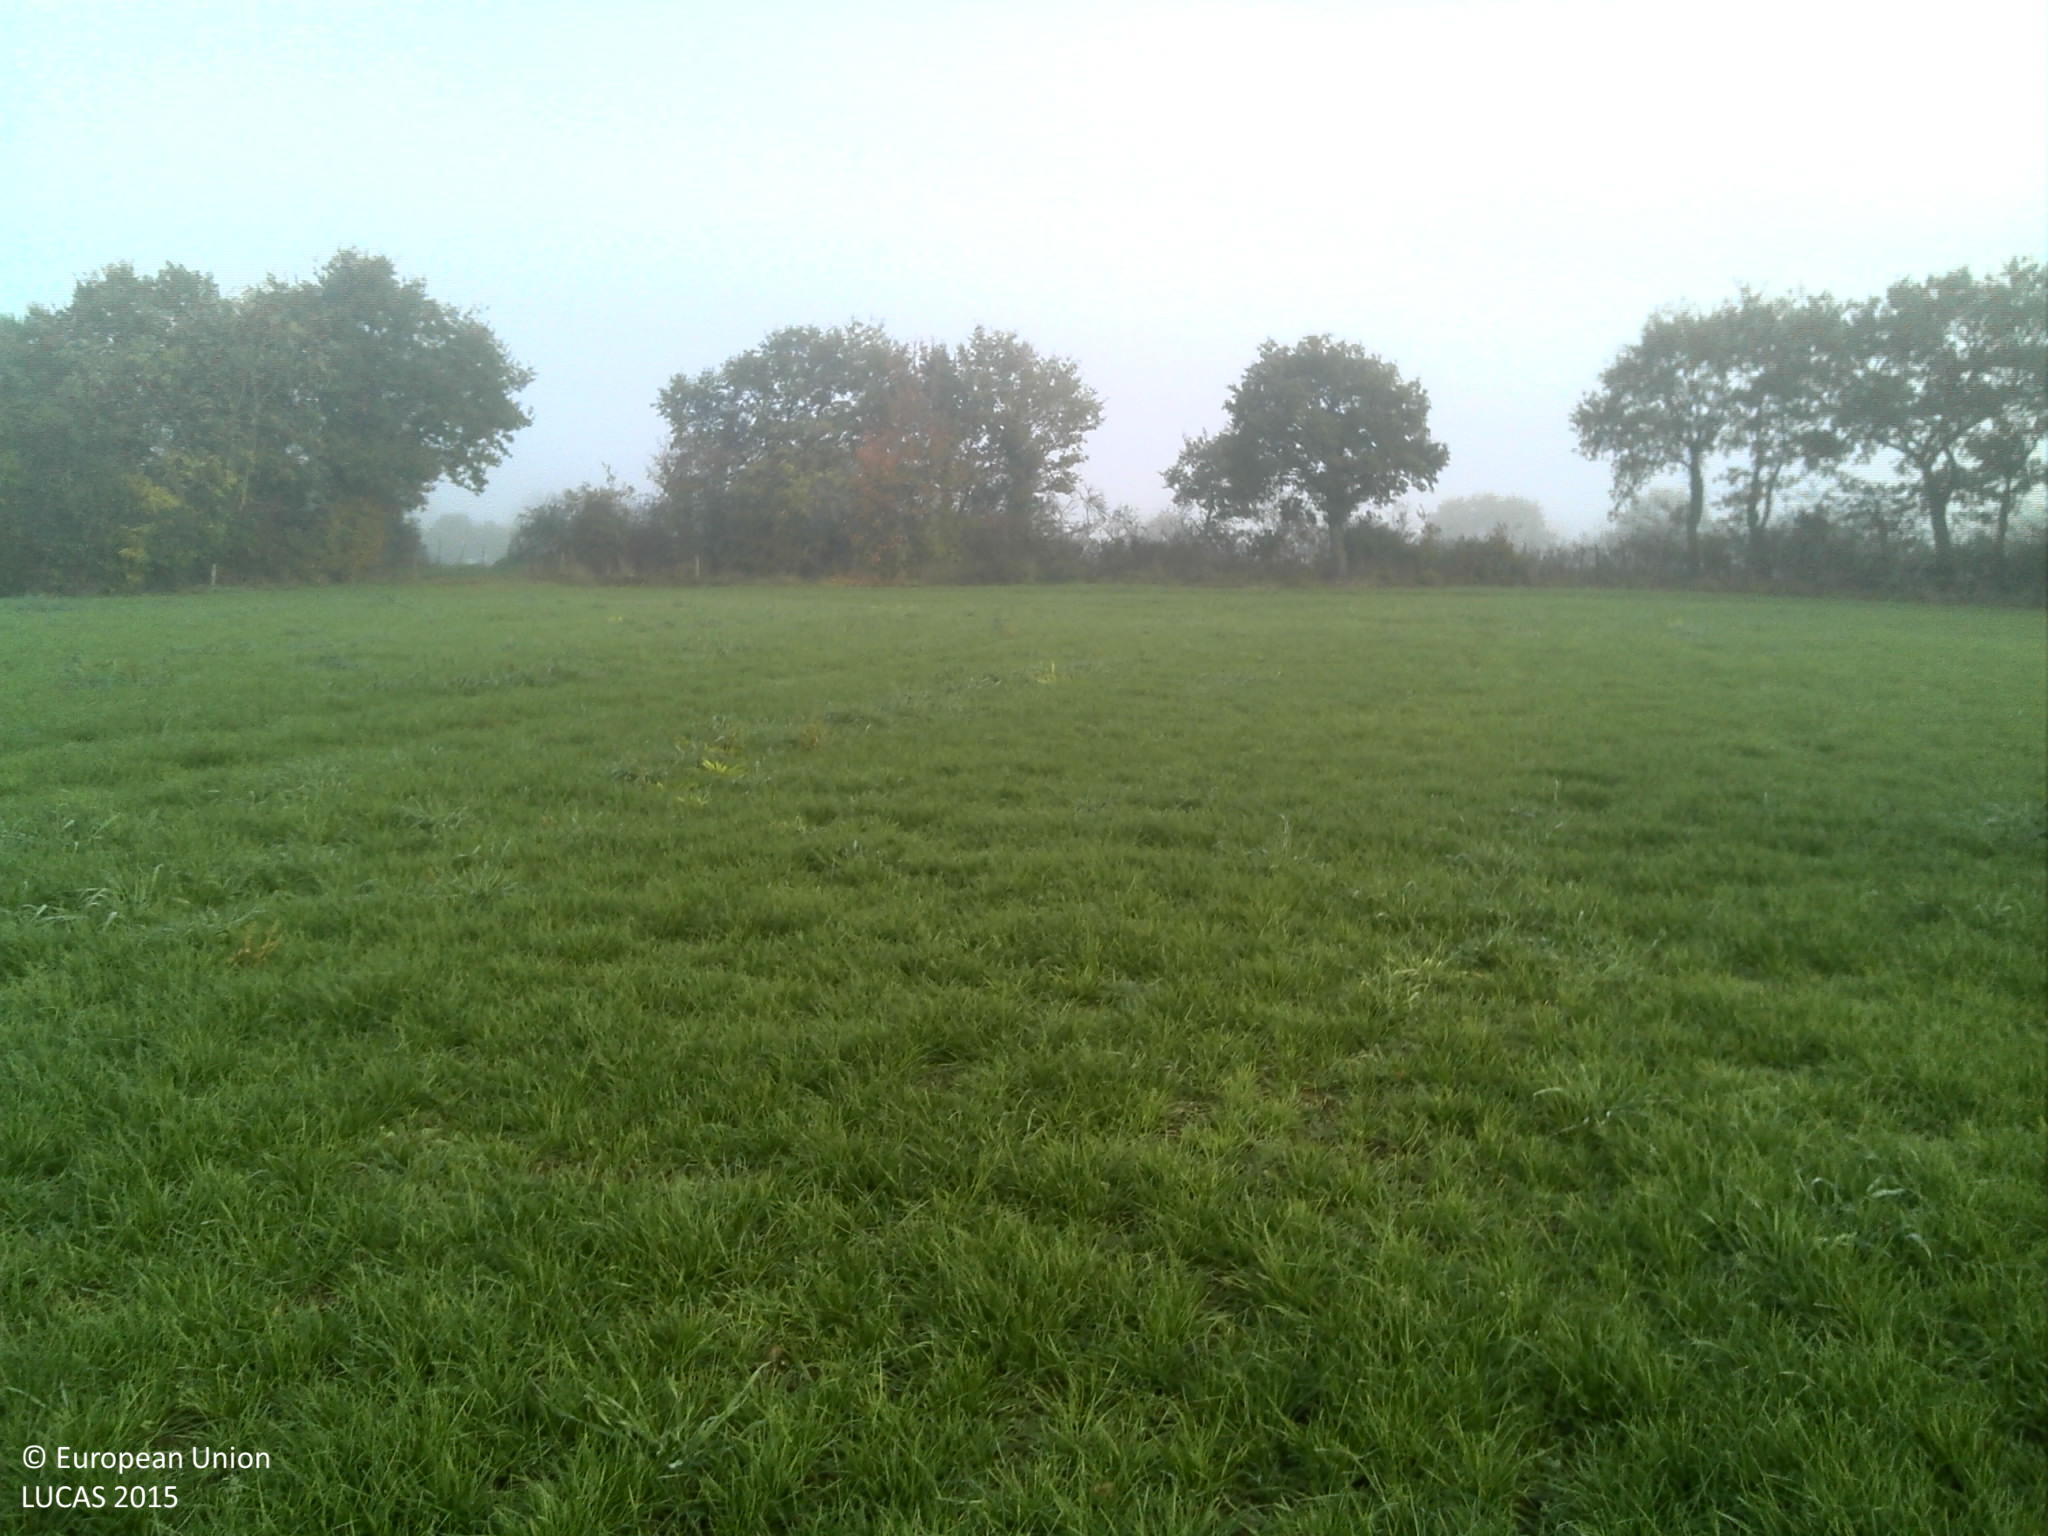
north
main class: Grassland
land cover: Grassland without tree/shrub cover
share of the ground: > 75 %
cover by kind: herbaceous plants 100 %
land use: Agriculture (excluding fallow land and kitchen gardens)
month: November
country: FR
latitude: 47.4038
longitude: -1.4777
